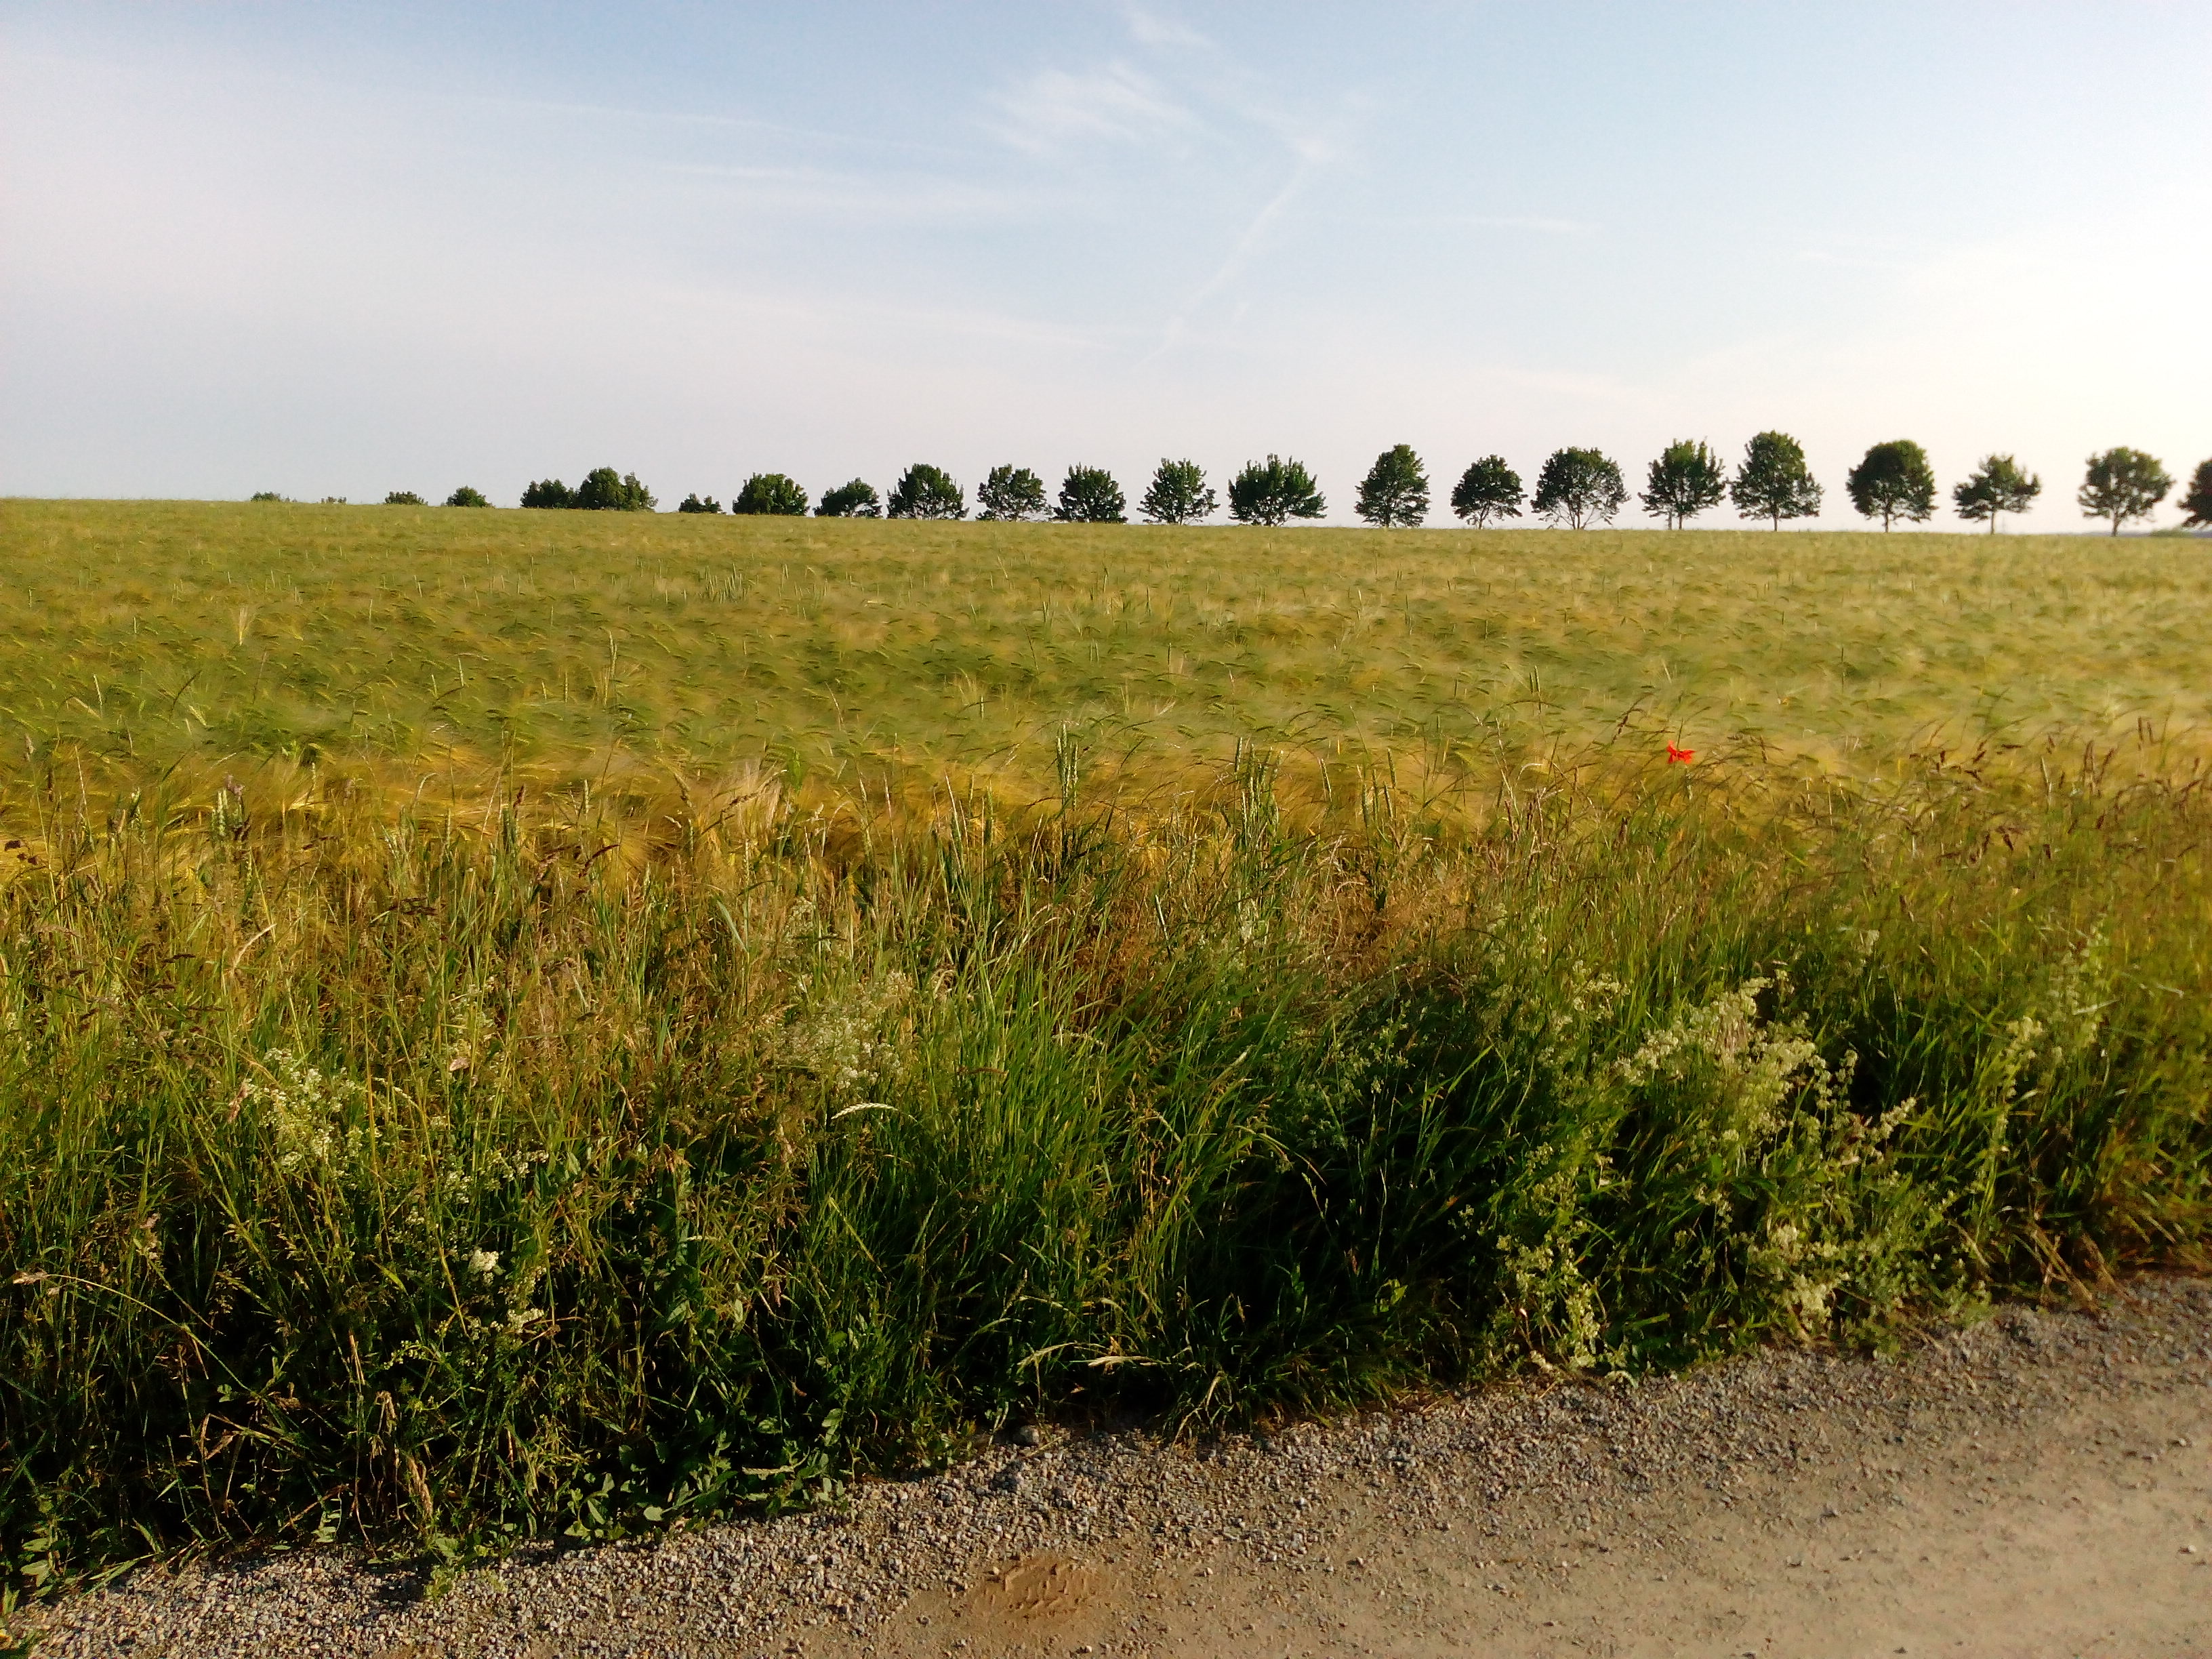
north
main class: Cropland
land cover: Common wheat
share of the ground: > 75 %
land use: Agriculture (excluding fallow land and kitchen gardens)
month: June
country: DE
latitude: 50.7727
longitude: 11.0632
